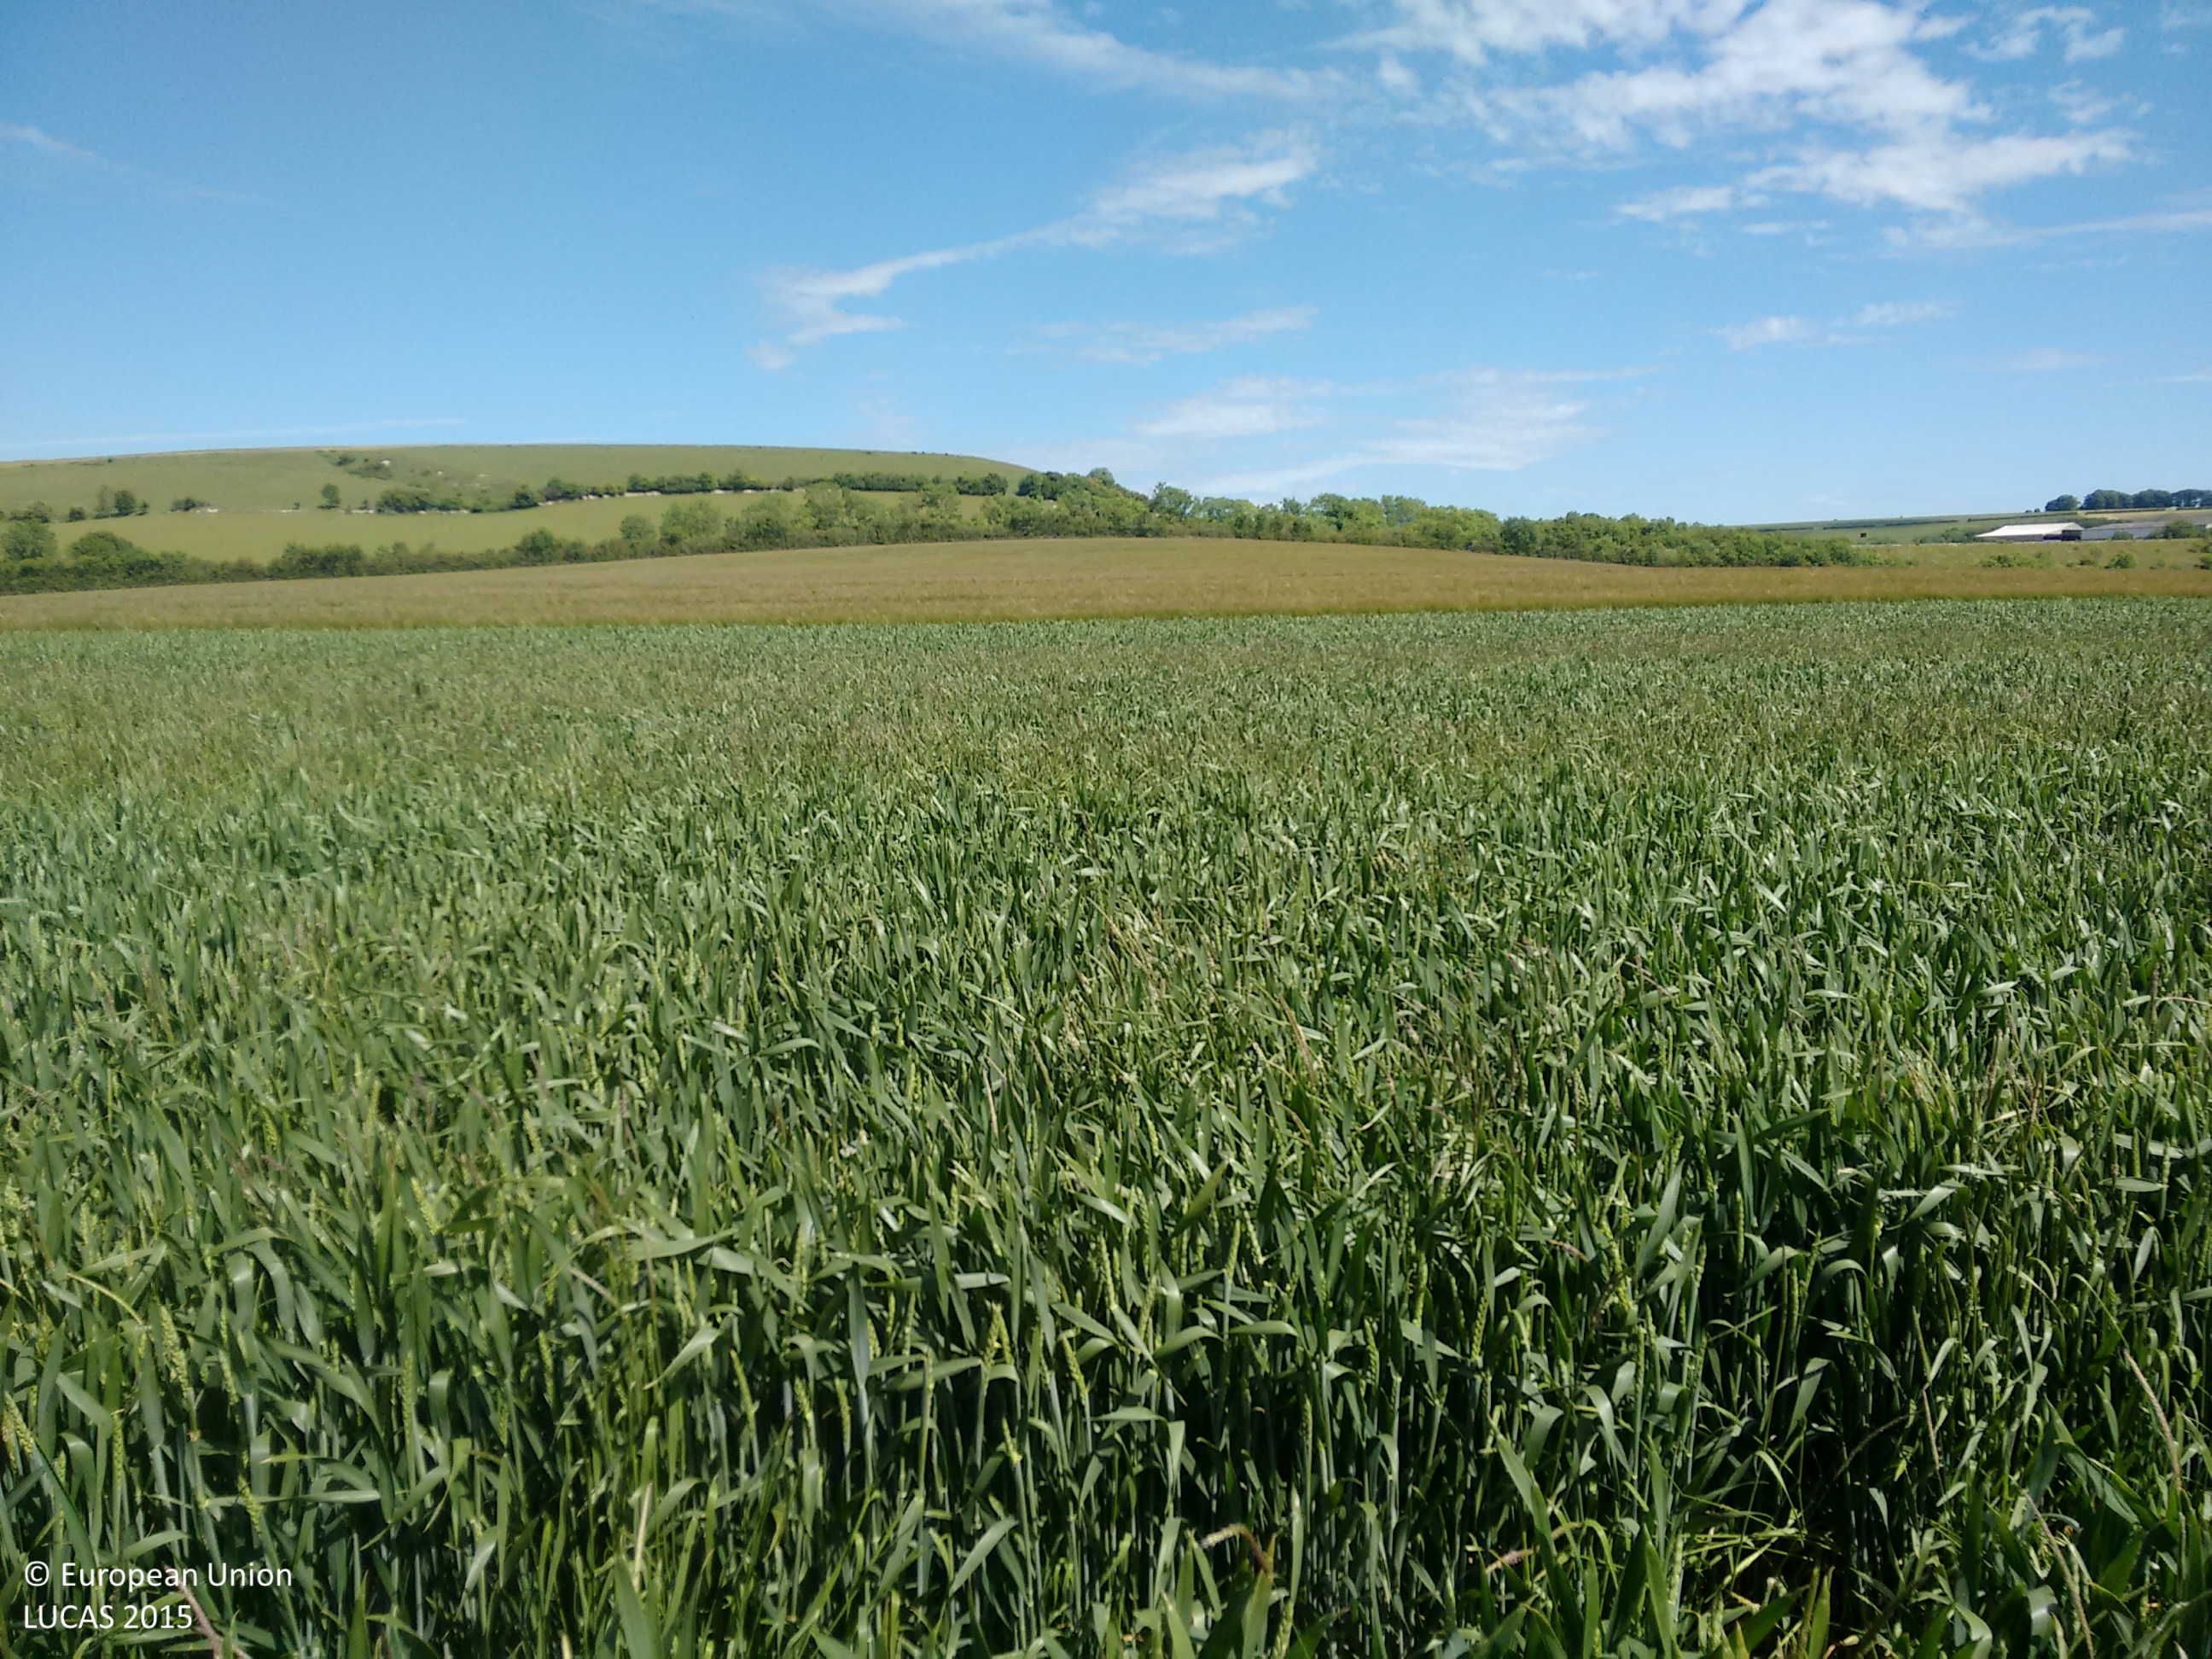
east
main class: Cropland
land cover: Common wheat
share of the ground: > 75 %
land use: Agriculture (excluding fallow land and kitchen gardens)
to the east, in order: Common wheat; Barley
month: June
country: GB
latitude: 51.2368
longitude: -2.1929
